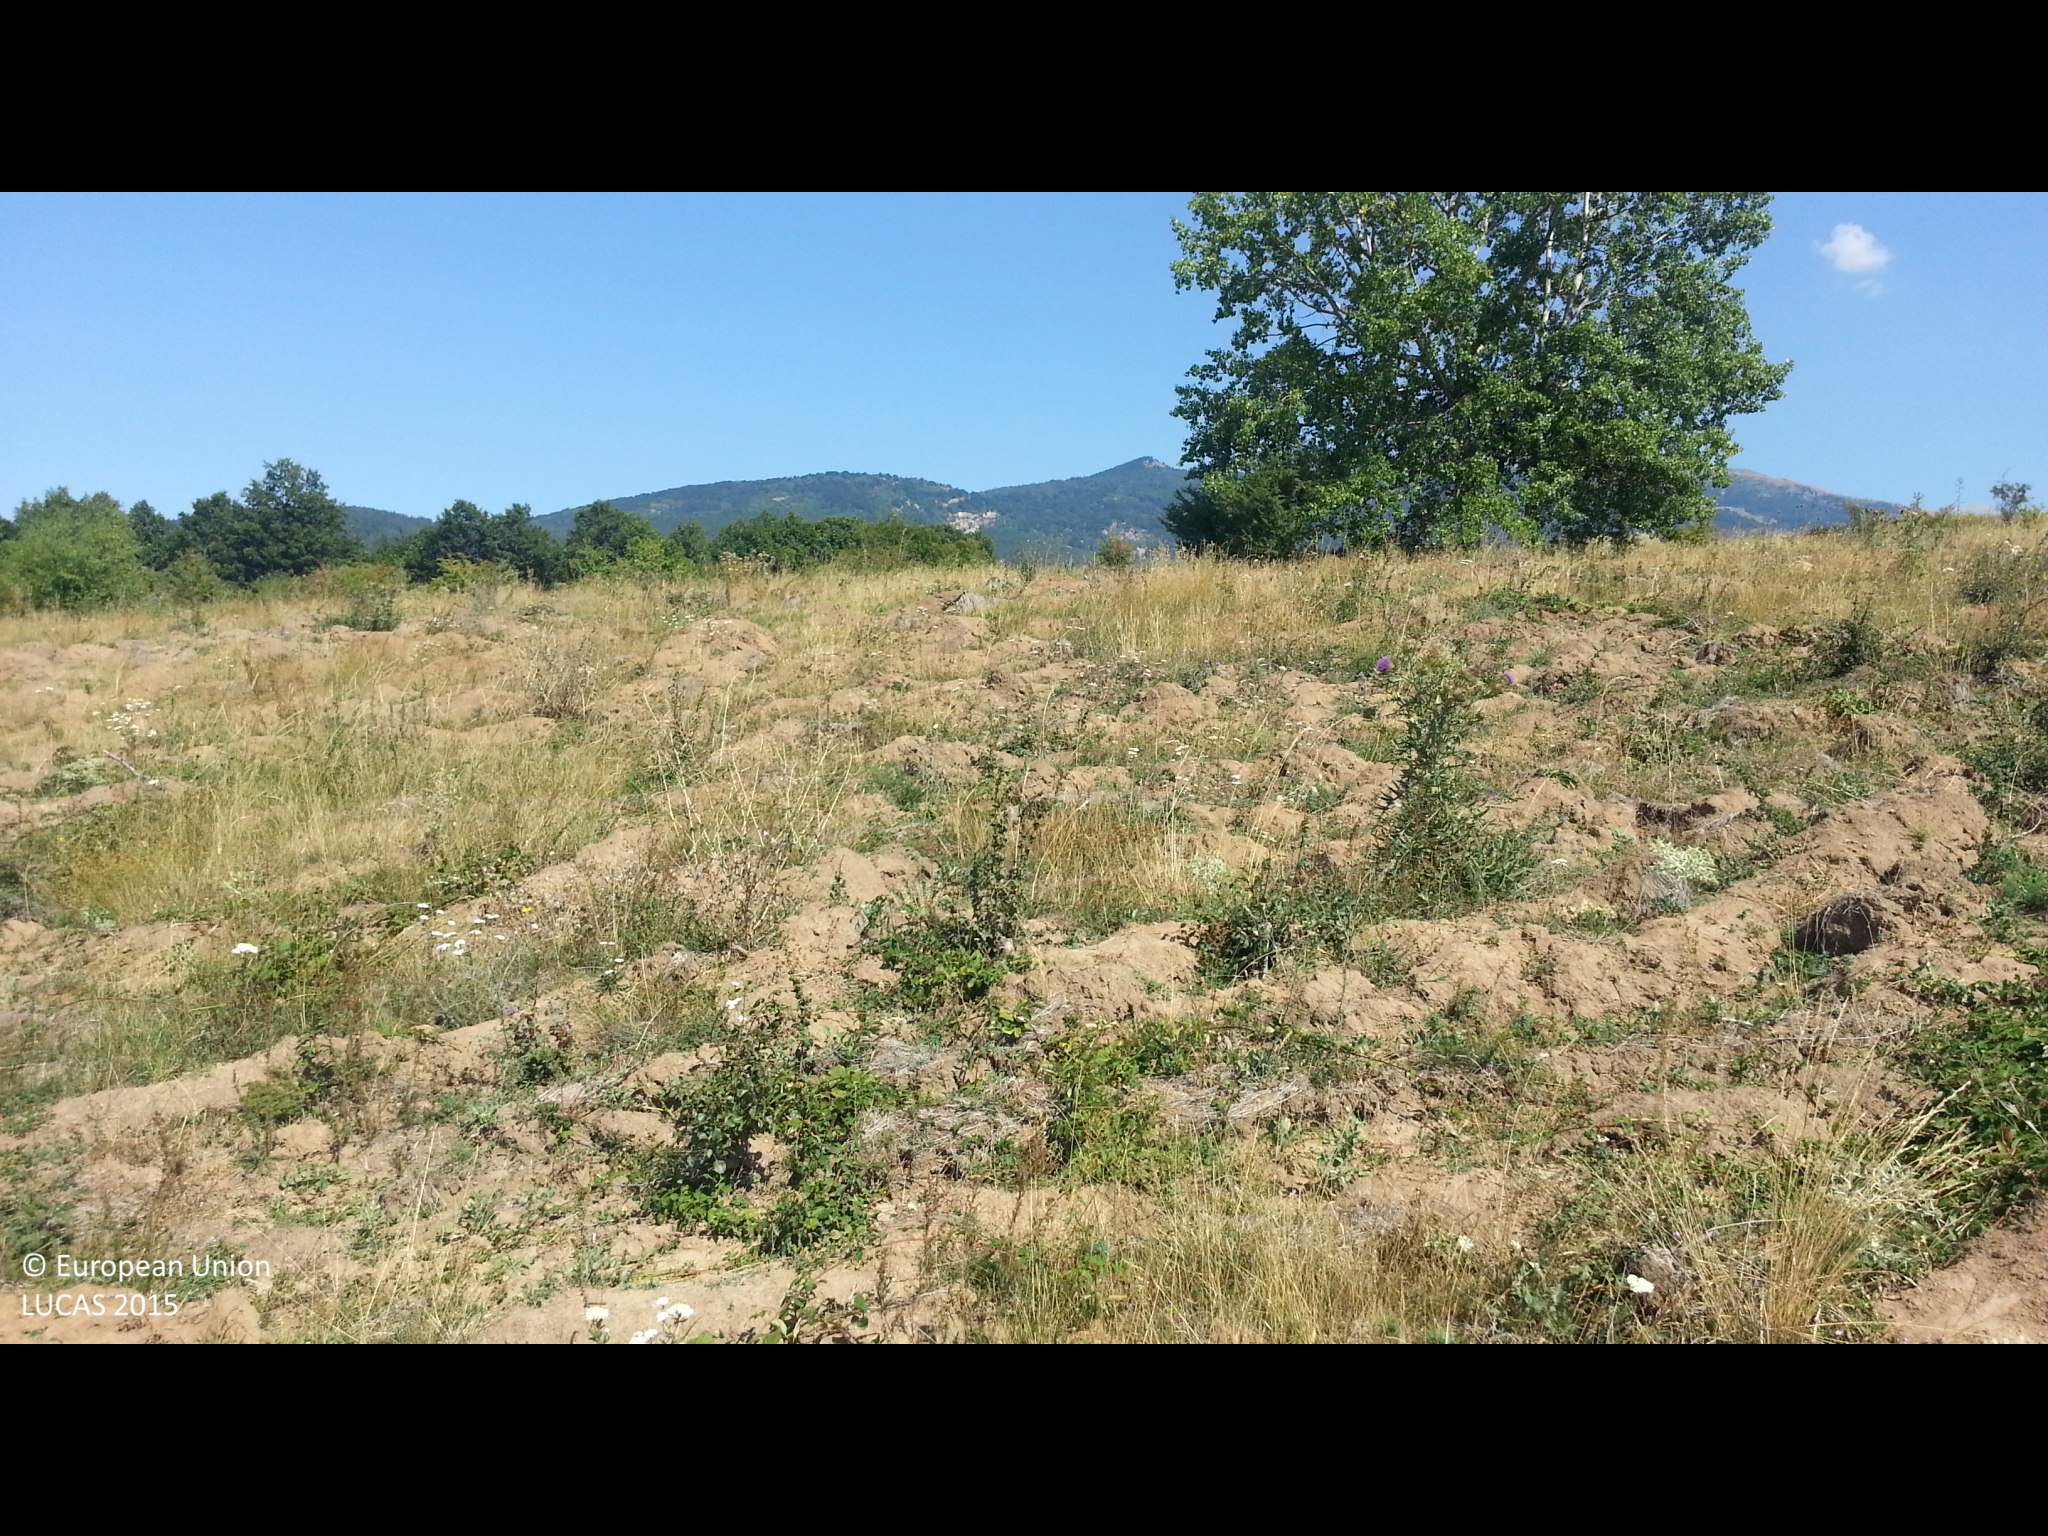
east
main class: Grassland
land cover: Spontaneously vegetated surfaces
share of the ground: 50 - 75 %
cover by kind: herbaceous plants 70 %, unconsolidated bare surface 30 %
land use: Fallow land
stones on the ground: < 10 %
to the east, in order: Spontaneously vegetated surfaces; Single bushes/trees; Paved roads, cycling and walking lanes; Ditches and canals; Grassland without tree/shrub cover; Grassland with sparse tree/shrub cover; Shrubland without tree cover; Broadleaved woodland
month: August
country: BG
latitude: 42.5779
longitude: 23.1525
